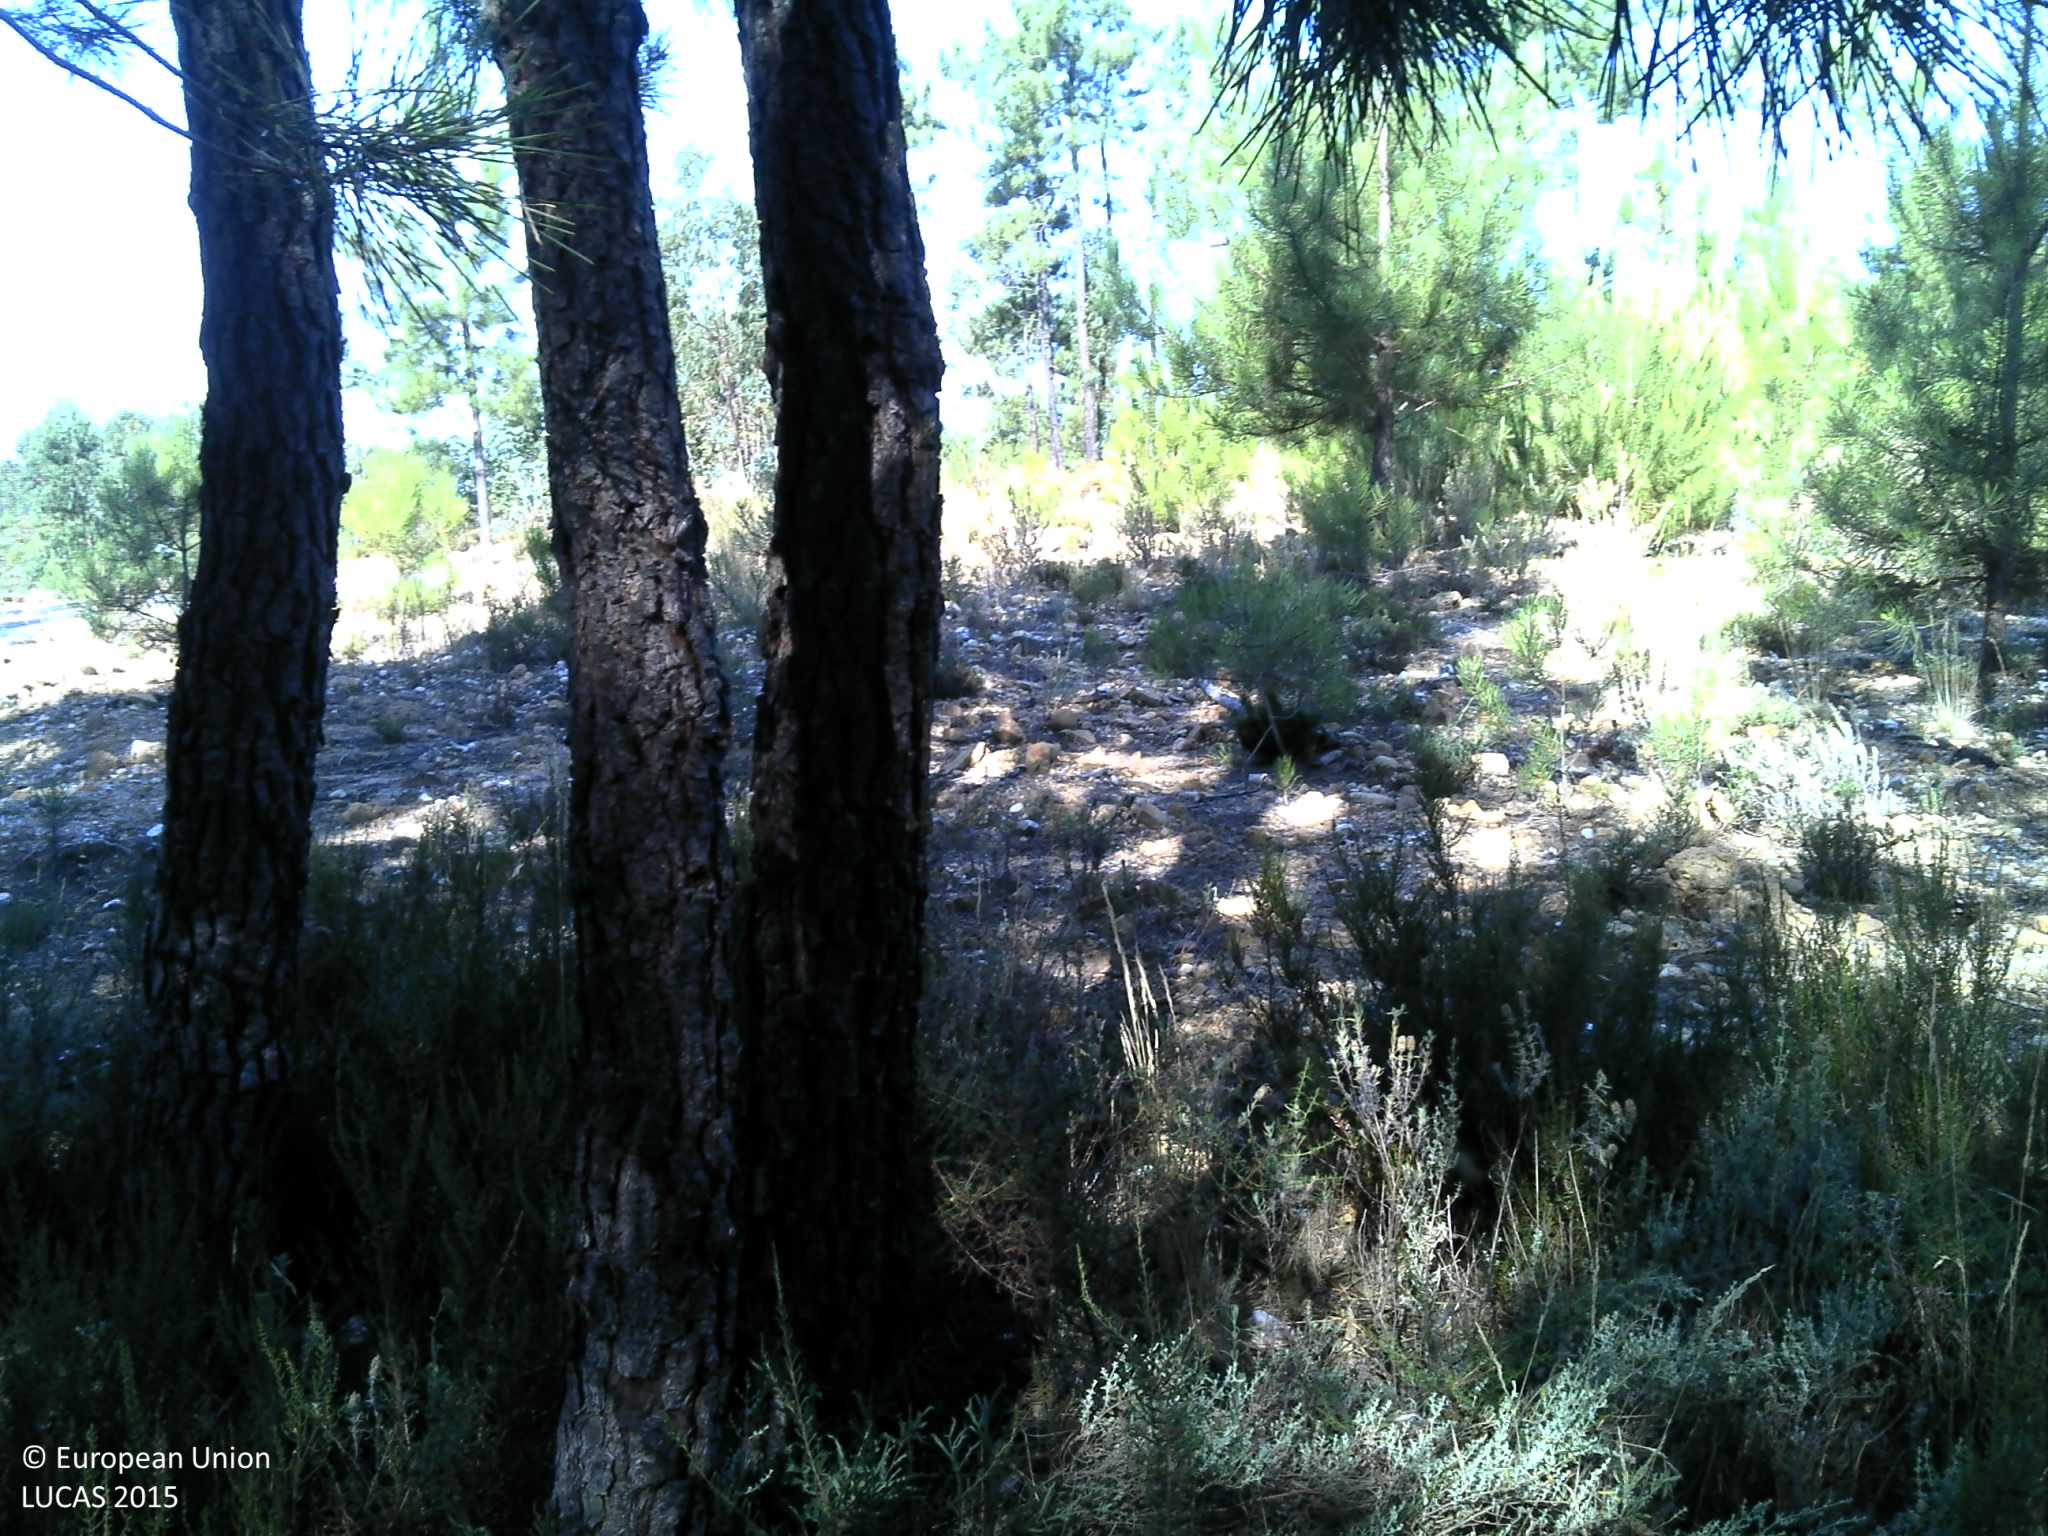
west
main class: Woodland
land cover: Pine dominated coniferous woodland
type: coniferous forest of the mediterranean region
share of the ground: 25 - 50 %
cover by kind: coniferous forest trees 45 %, shrubs 30 %, unconsolidated bare surface 10 %, consolidated bare surface 5 %
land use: Forestry
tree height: > 5 m
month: July
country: PT
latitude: 39.5100
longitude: -8.0056
